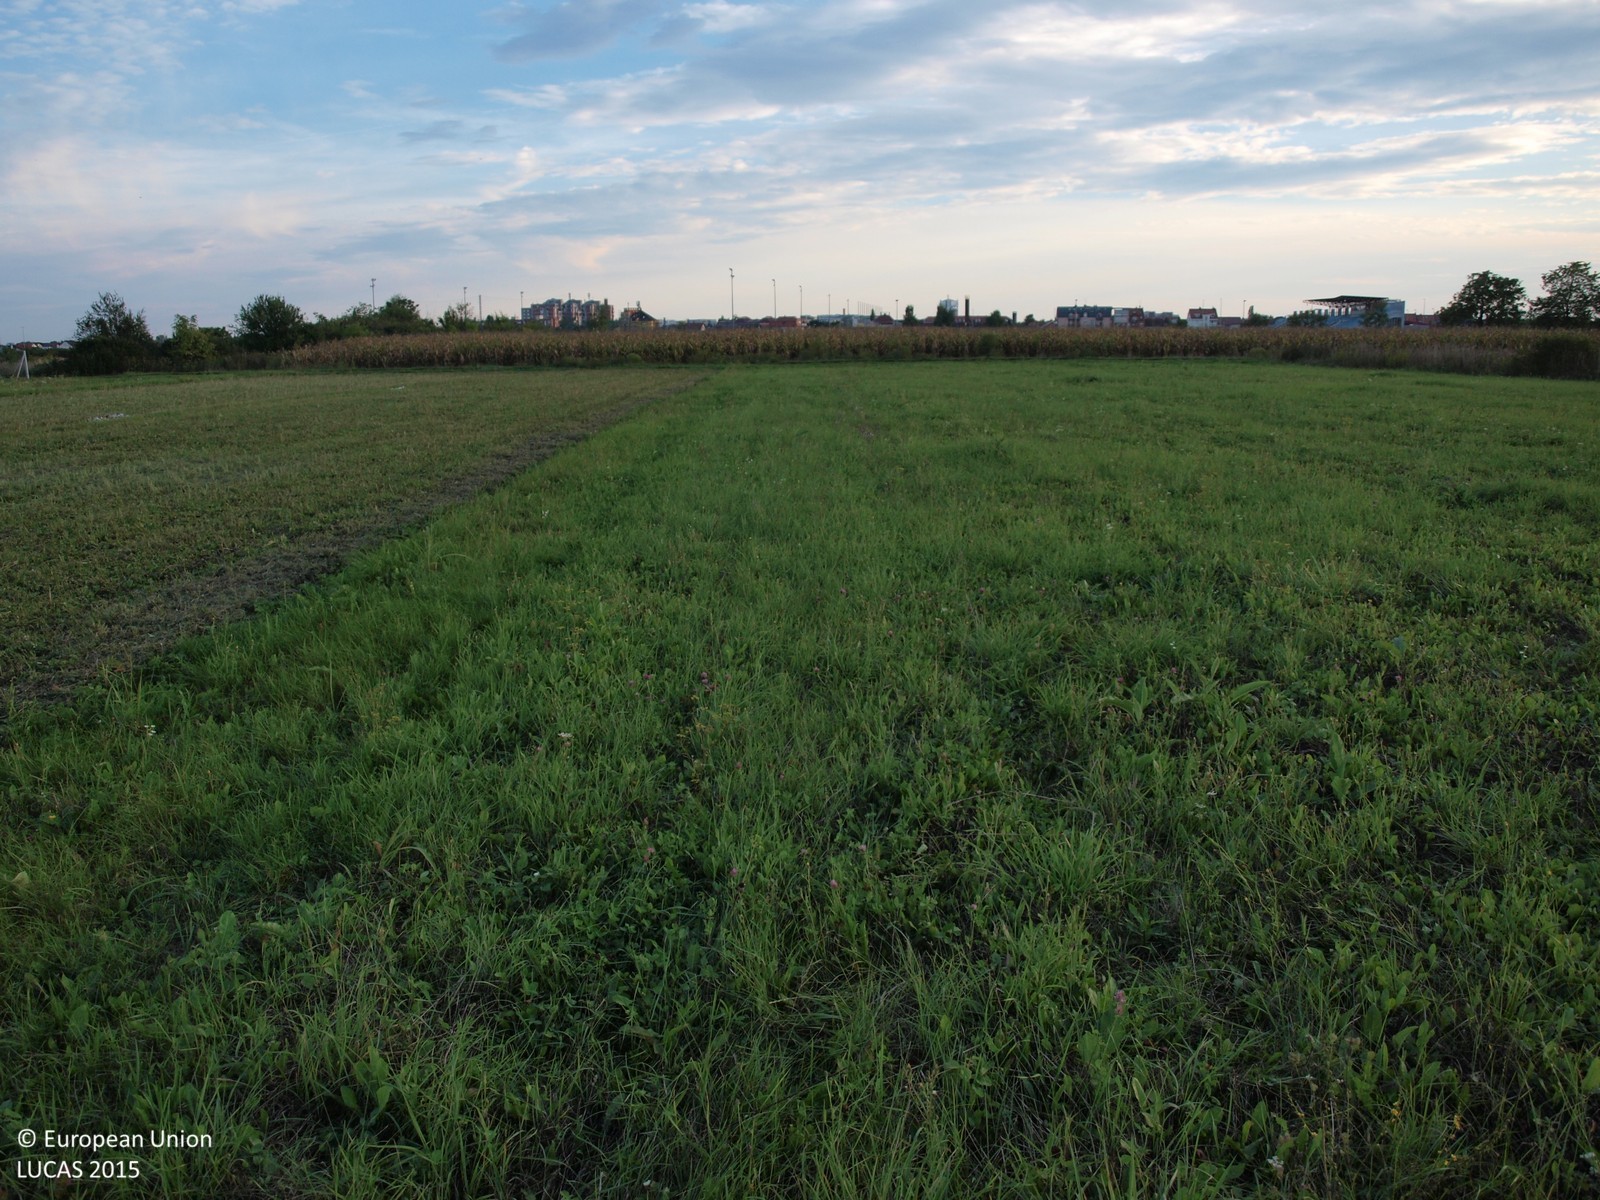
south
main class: Grassland
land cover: Grassland without tree/shrub cover
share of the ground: > 75 %
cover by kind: herbaceous plants 100 %
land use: Agriculture (excluding fallow land and kitchen gardens)
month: September
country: HR
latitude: 45.7269
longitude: 16.0756
